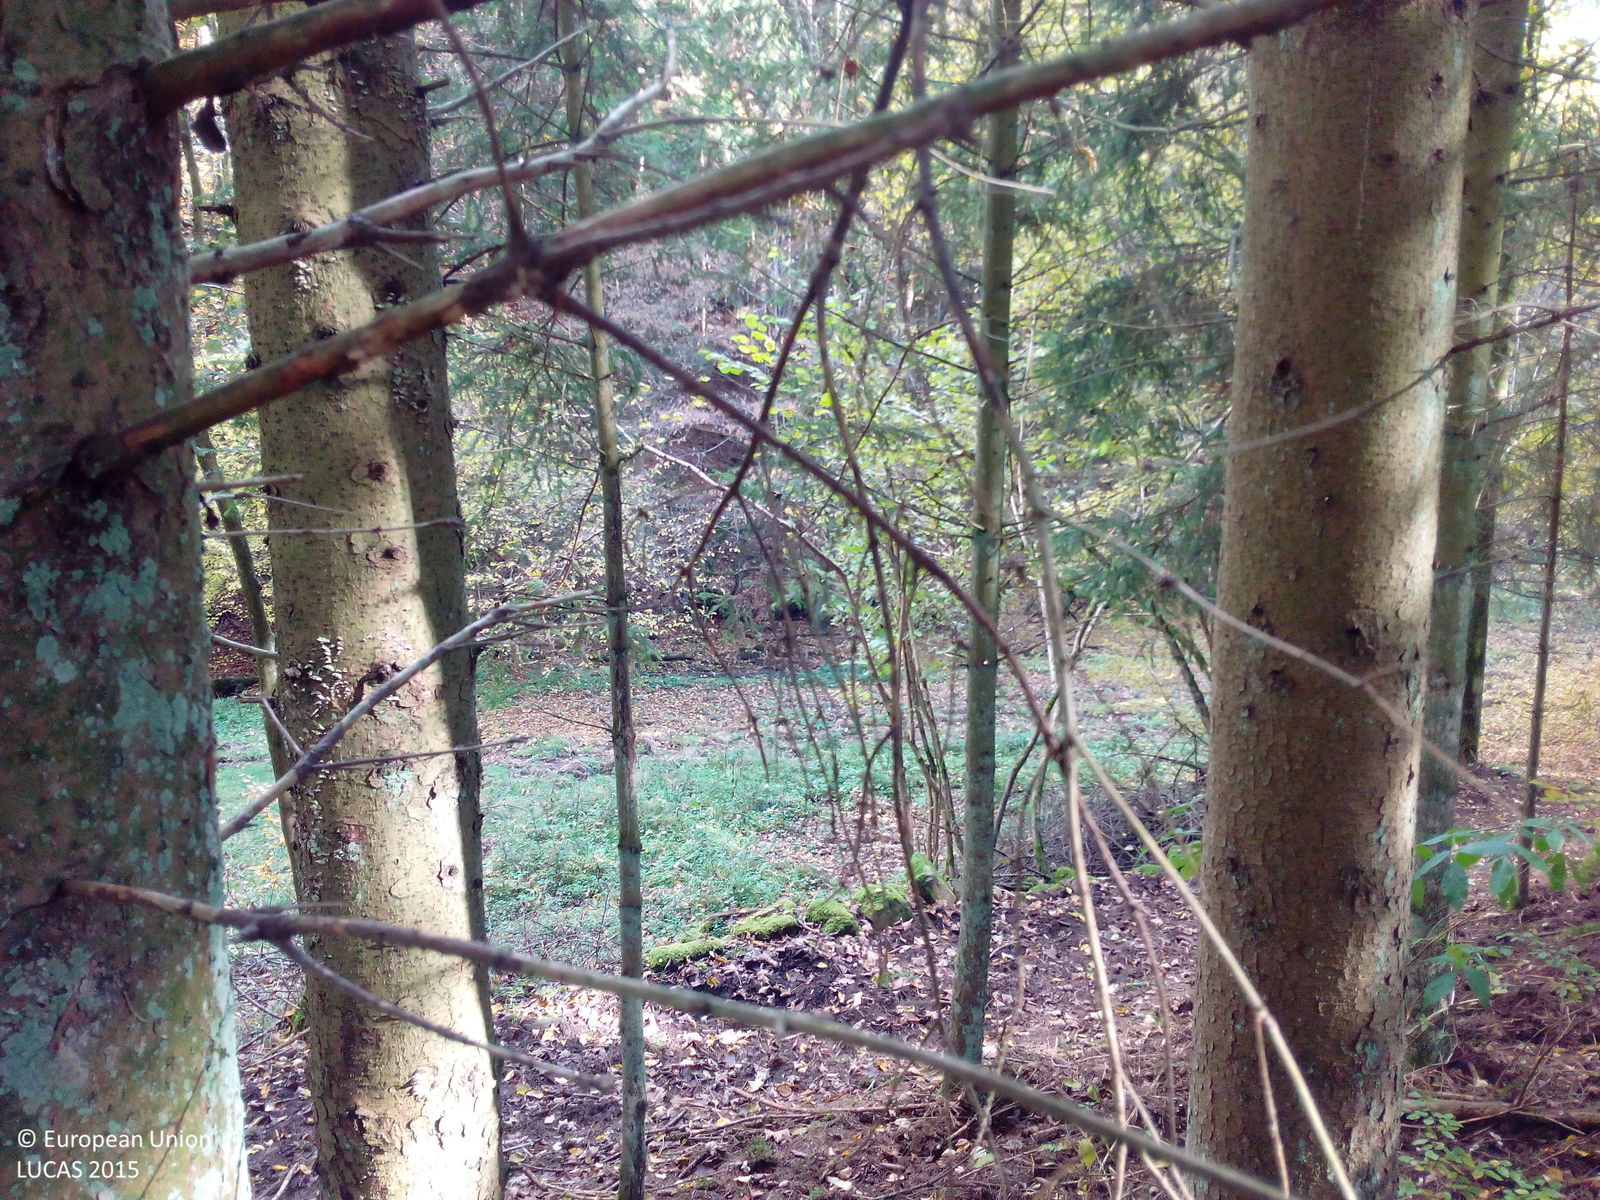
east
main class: Woodland
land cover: Spruce dominated coniferous woodland
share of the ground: 50 - 75 %
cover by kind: coniferous forest trees 65 %, unconsolidated bare surface 15 %, lichens and mosses 10 %, broadleaved forest trees 5 %, shrubs 5 %
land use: Forestry
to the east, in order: Spruce dominated coniferous woodland; Tracks; Lines of trees; Grassland without tree/shrub cover; Fences; Rivers and streams; Spruce dominated mixed woodland; Spruce dominated coniferous woodland; Tracks; Spruce dominated coniferous woodland; Broadleaved woodland; Inland fresh running water; Artificial constructions in urban areas; Grassland without tree/shrub cover
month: October
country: DE
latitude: 50.3460
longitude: 9.8736
